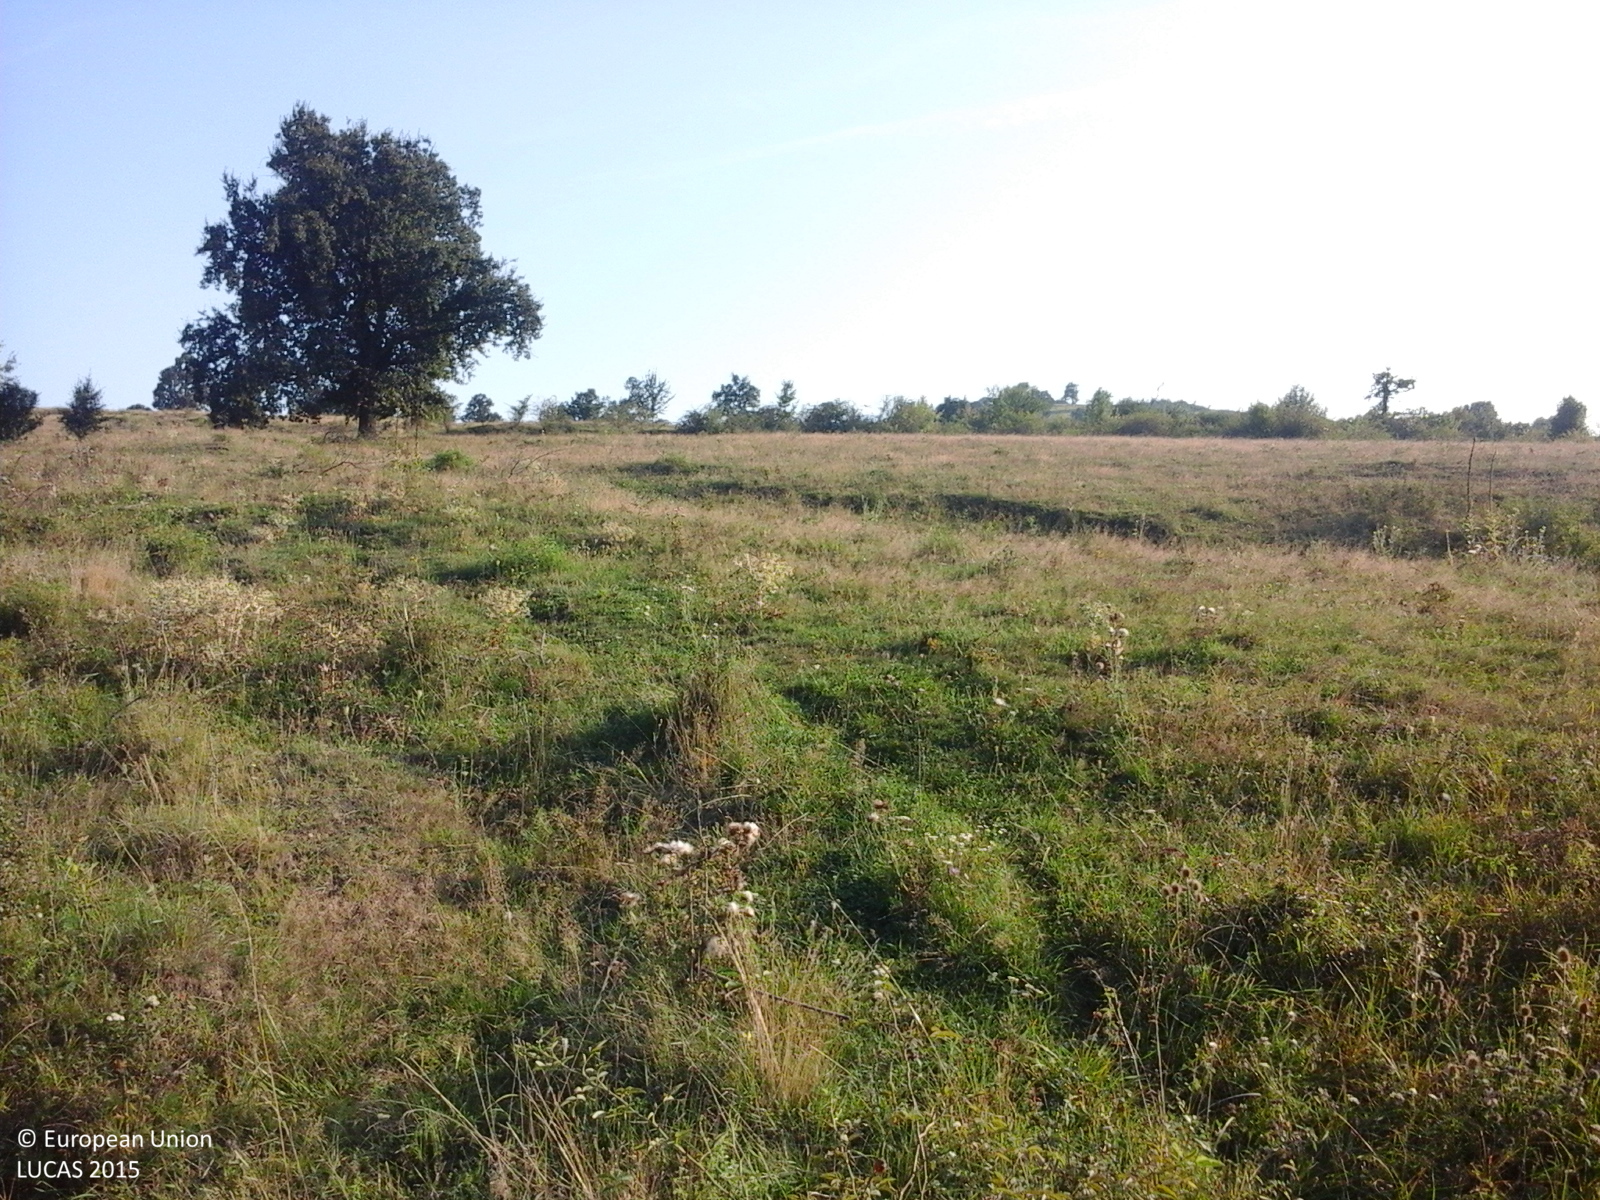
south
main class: Grassland
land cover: Grassland with sparse tree/shrub cover
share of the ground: > 75 %
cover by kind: herbaceous plants 90 %, broadleaved forest trees 5 %, shrubs 5 %
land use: Agriculture (excluding fallow land and kitchen gardens)
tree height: < 5 m
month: September
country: RO
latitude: 47.2422
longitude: 22.7552
